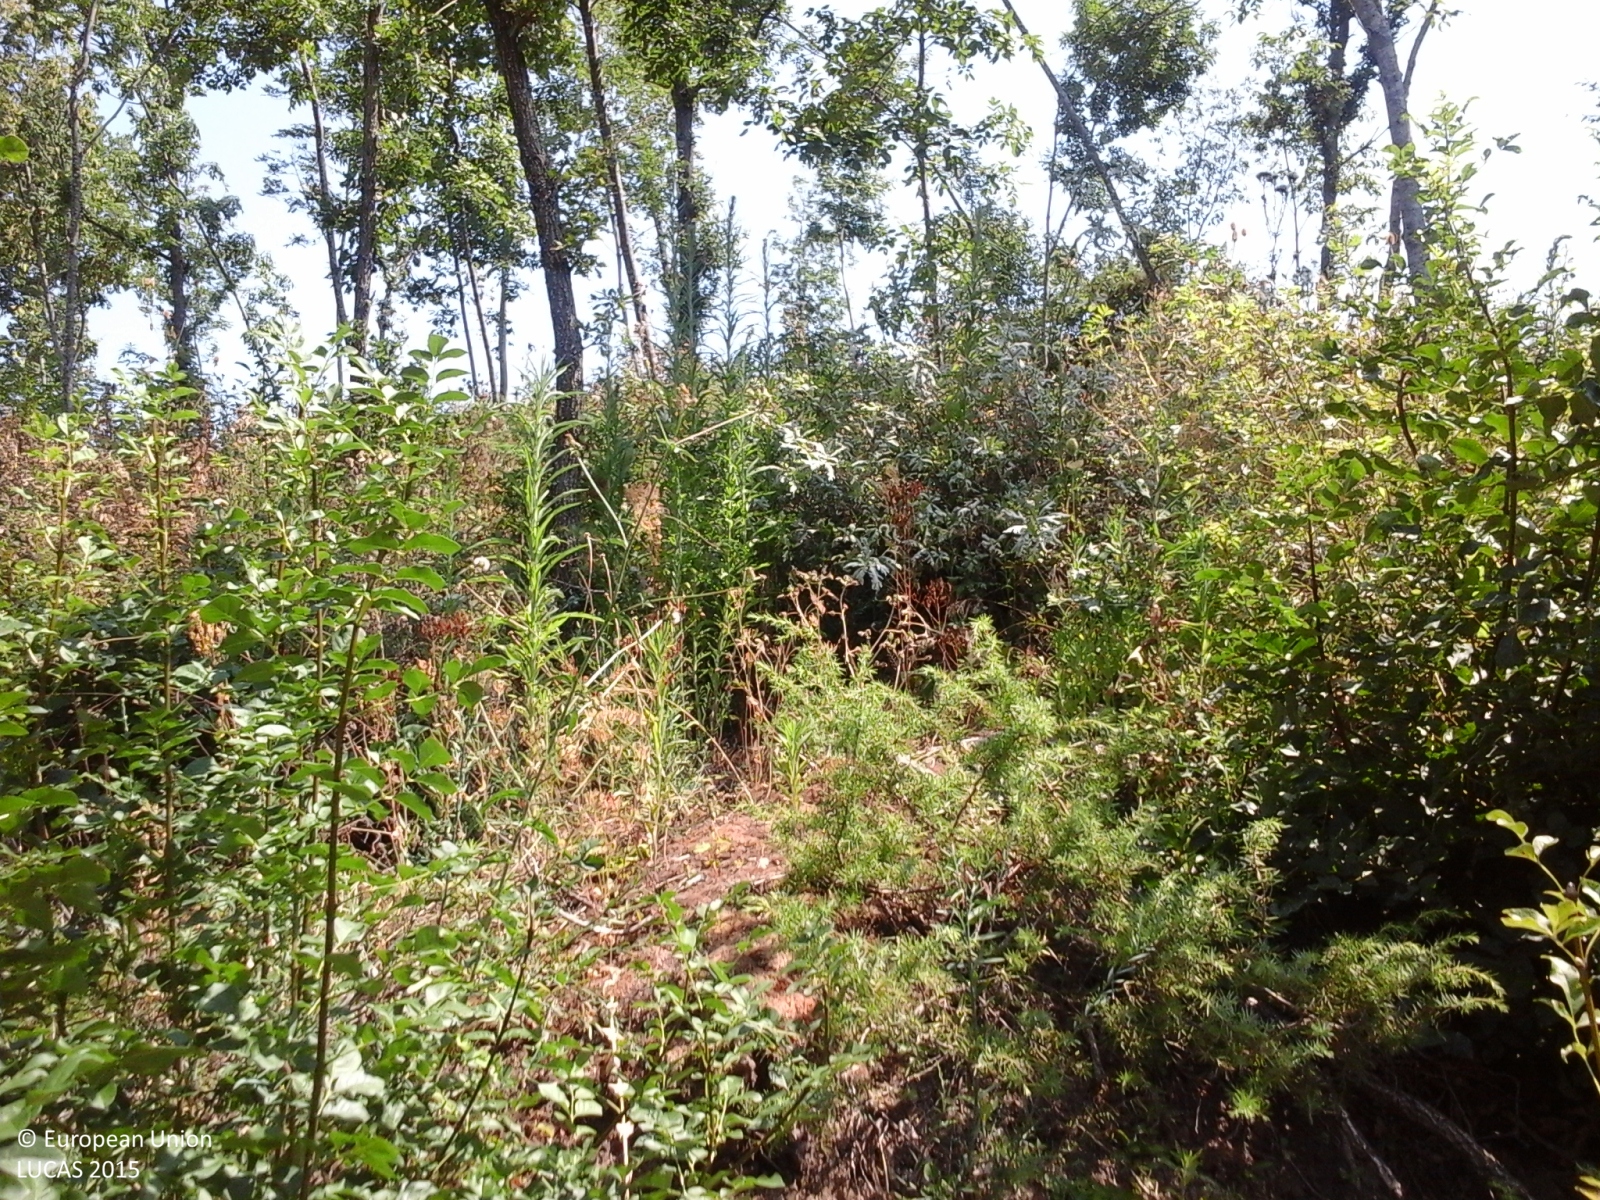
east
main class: Woodland
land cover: Broadleaved woodland
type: thermophilous deciduous forest
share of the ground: > 75 %
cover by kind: broadleaved forest trees 100 %
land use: Forestry
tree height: > 5 m
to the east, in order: Broadleaved woodland; Grassland without tree/shrub cover; Fences; Abandoned hedges; Tracks; Grassland without tree/shrub cover; Electric lines; Grassland without tree/shrub cover; Fences; Grassland with sparse tree/shrub cover; Fences; Grassland without tree/shrub cover
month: August
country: IT
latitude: 43.7094
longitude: 12.3892
